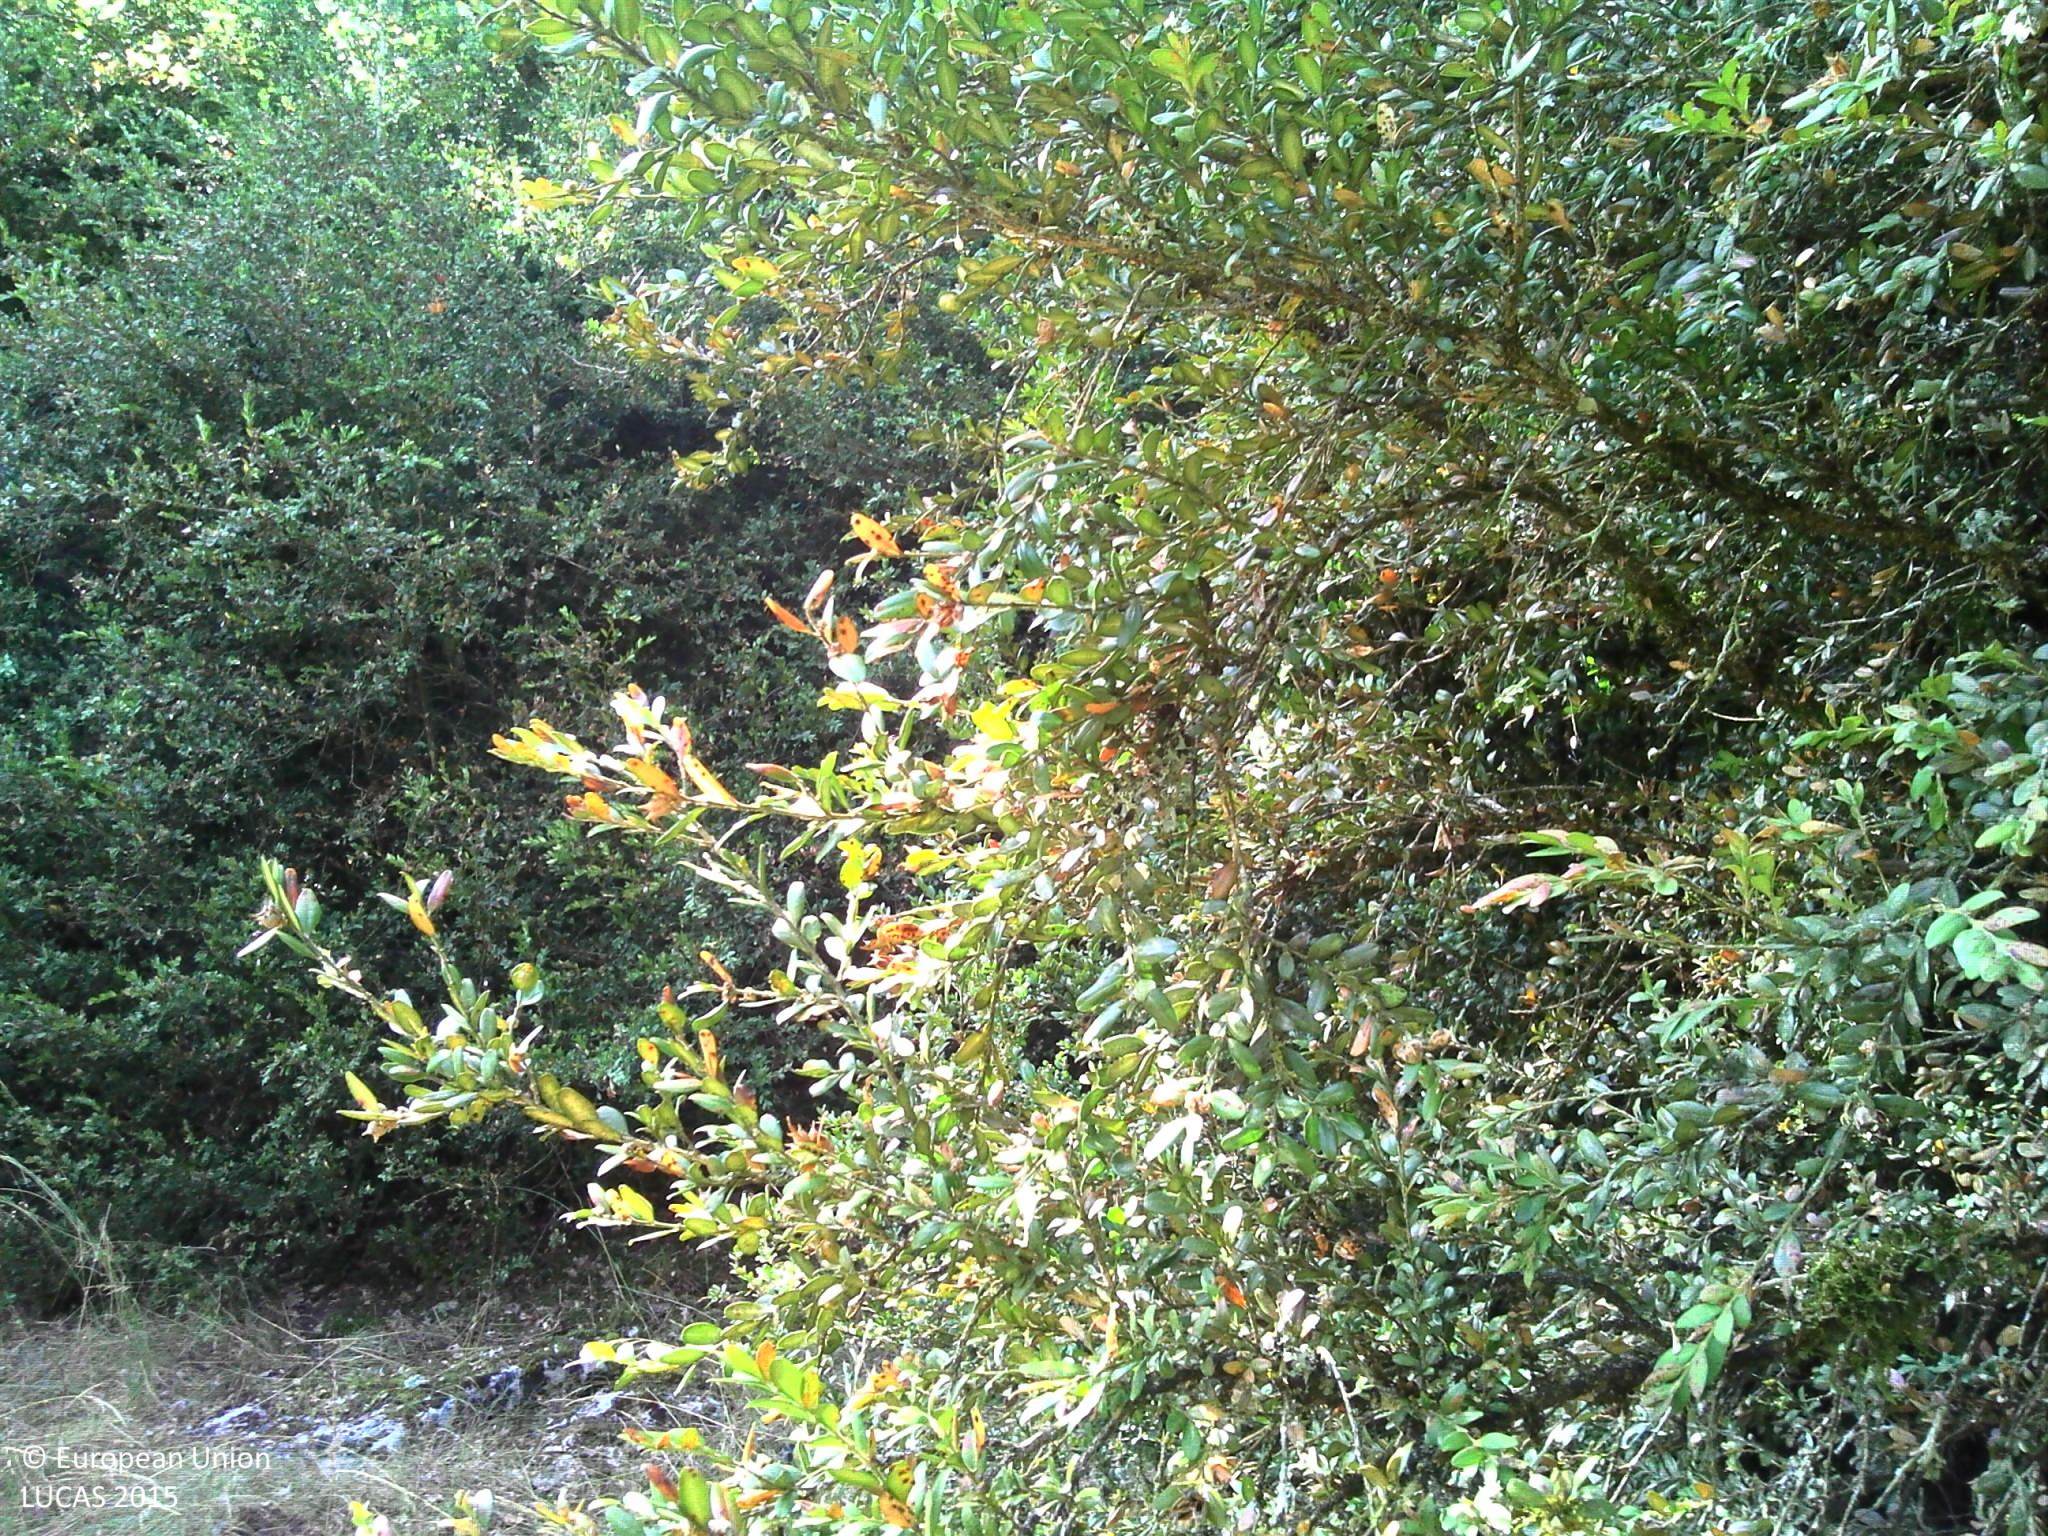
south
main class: Woodland
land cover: Broadleaved woodland
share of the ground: > 75 %
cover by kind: broadleaved forest trees 70 %, herbaceous plants 15 %, shrubs 10 %, lichens and mosses 5 %
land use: Forestry
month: August
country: FR
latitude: 43.8871
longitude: 3.1235
